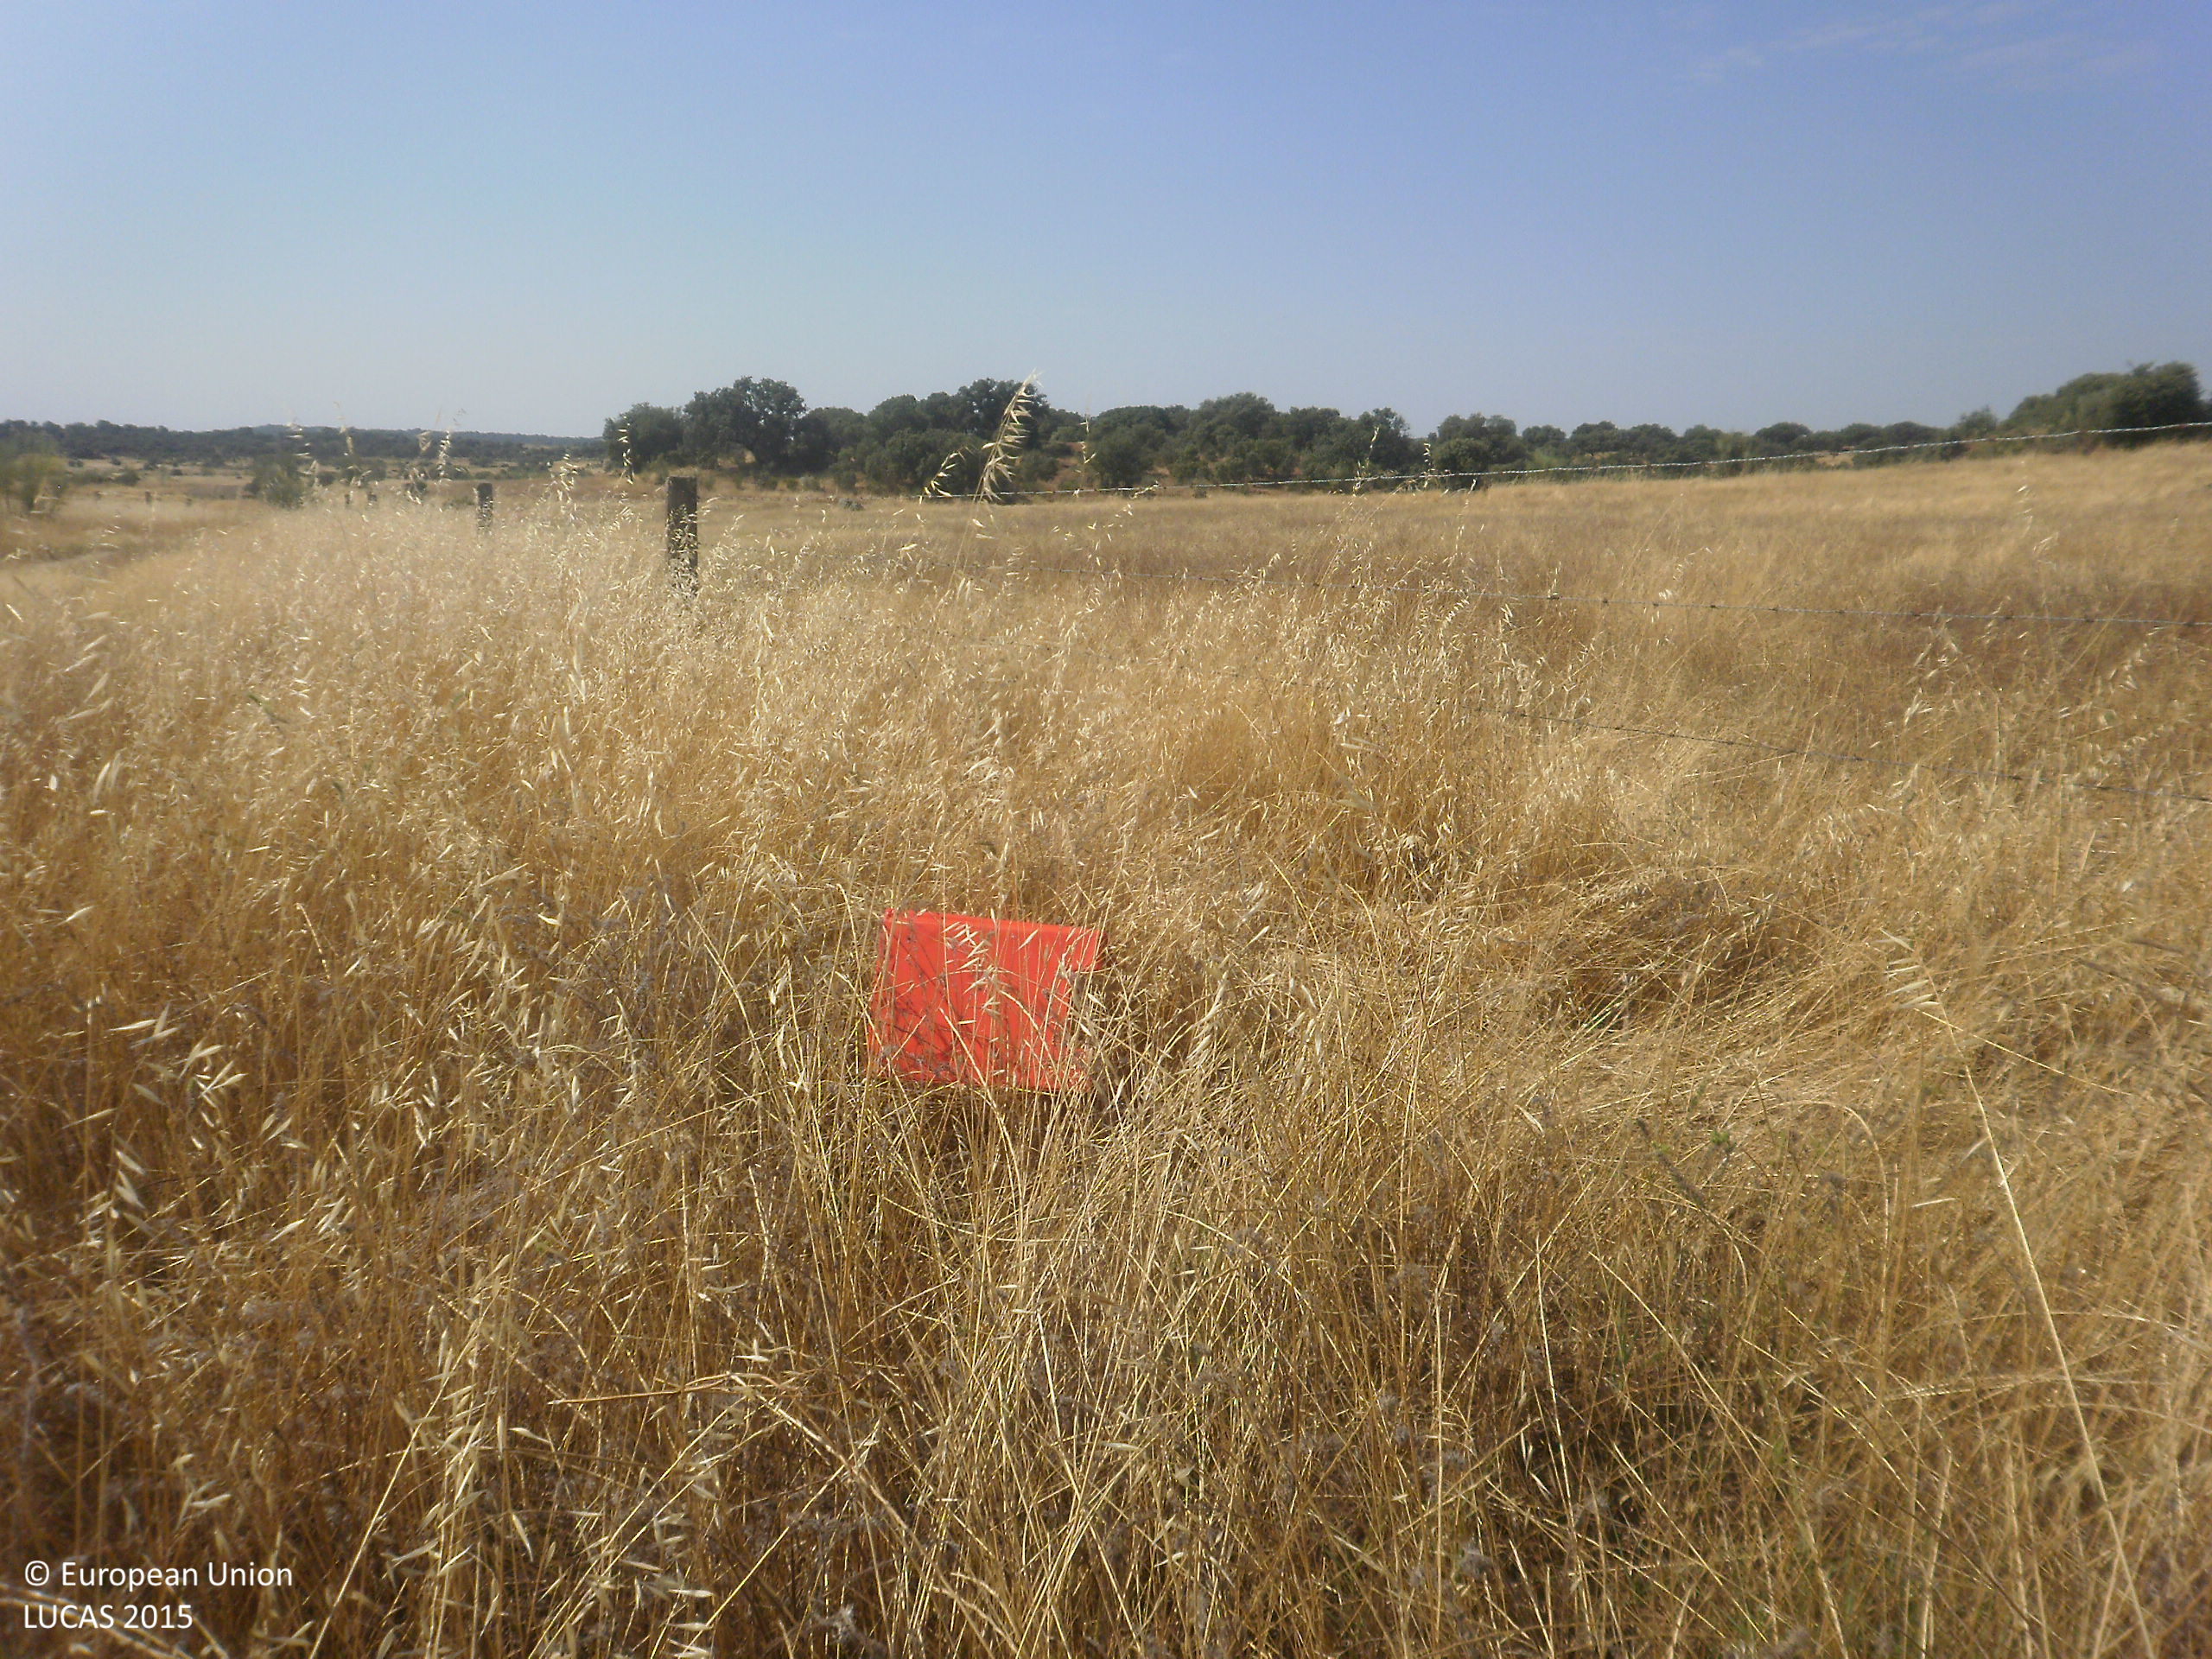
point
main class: Grassland
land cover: Grassland without tree/shrub cover
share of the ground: > 75 %
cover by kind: herbaceous plants 100 %
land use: Agriculture (excluding fallow land and kitchen gardens)
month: June
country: ES
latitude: 39.2134
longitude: -5.9333
